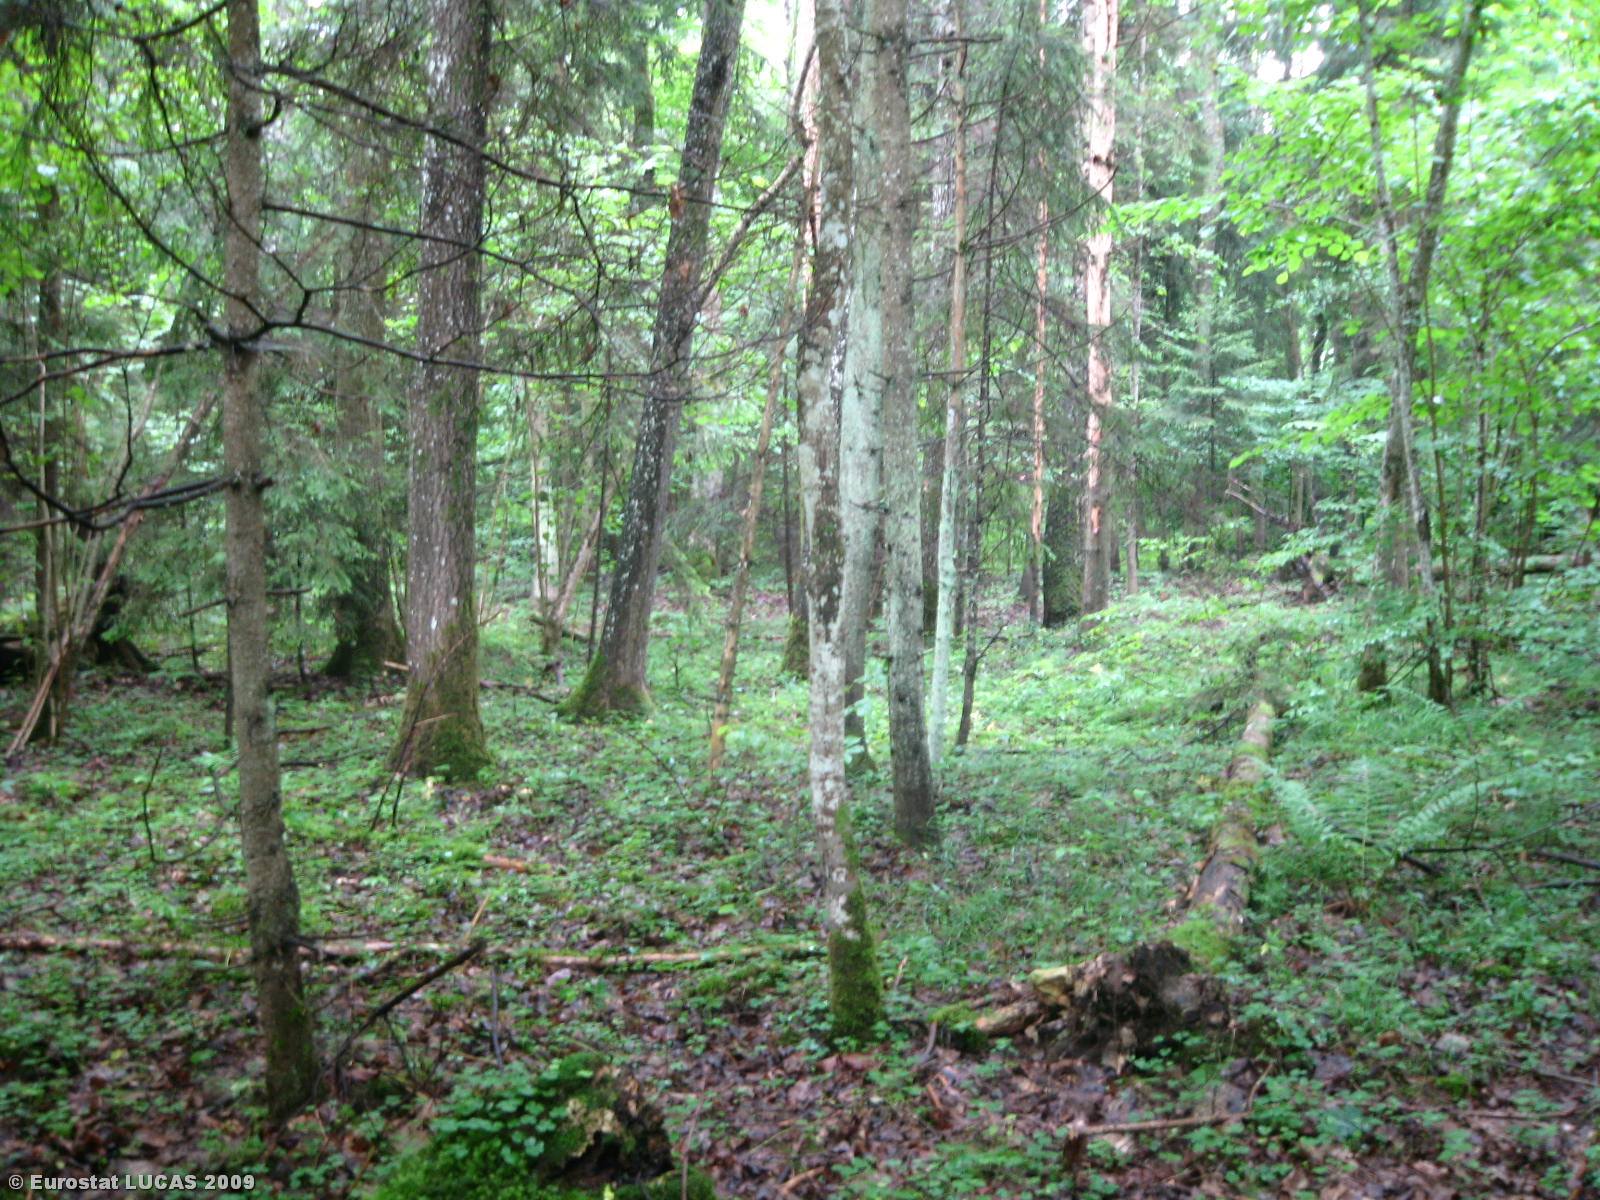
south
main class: Woodland
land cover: Mixed woodland
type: hemiboreal forest and nemoral coniferous forest and mixed broadleaved-coniferous forest
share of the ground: > 75 %
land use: Forestry
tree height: > 5 m
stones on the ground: < 10 %
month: July
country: LT
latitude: 55.1525
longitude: 24.8446
